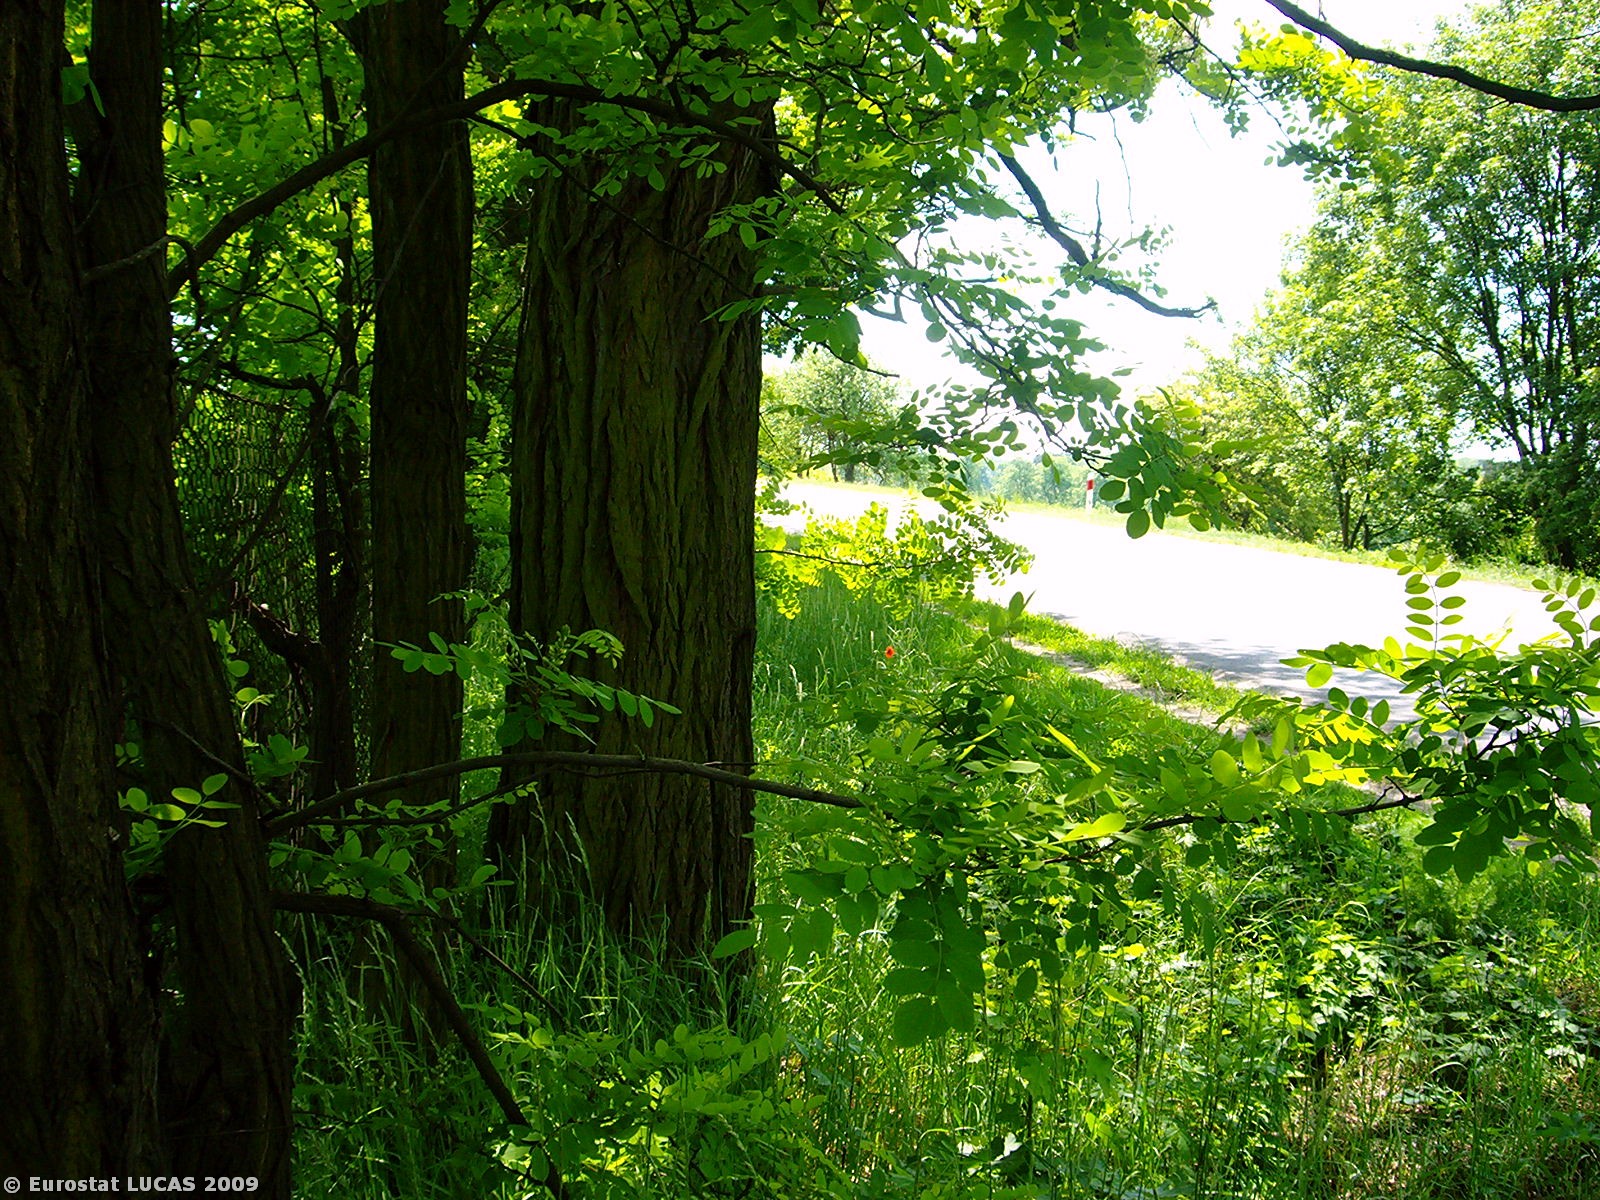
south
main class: Woodland
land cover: Broadleaved woodland
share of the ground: > 75 %
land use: Unused
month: May
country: PL
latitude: 52.4970
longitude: 16.9768
